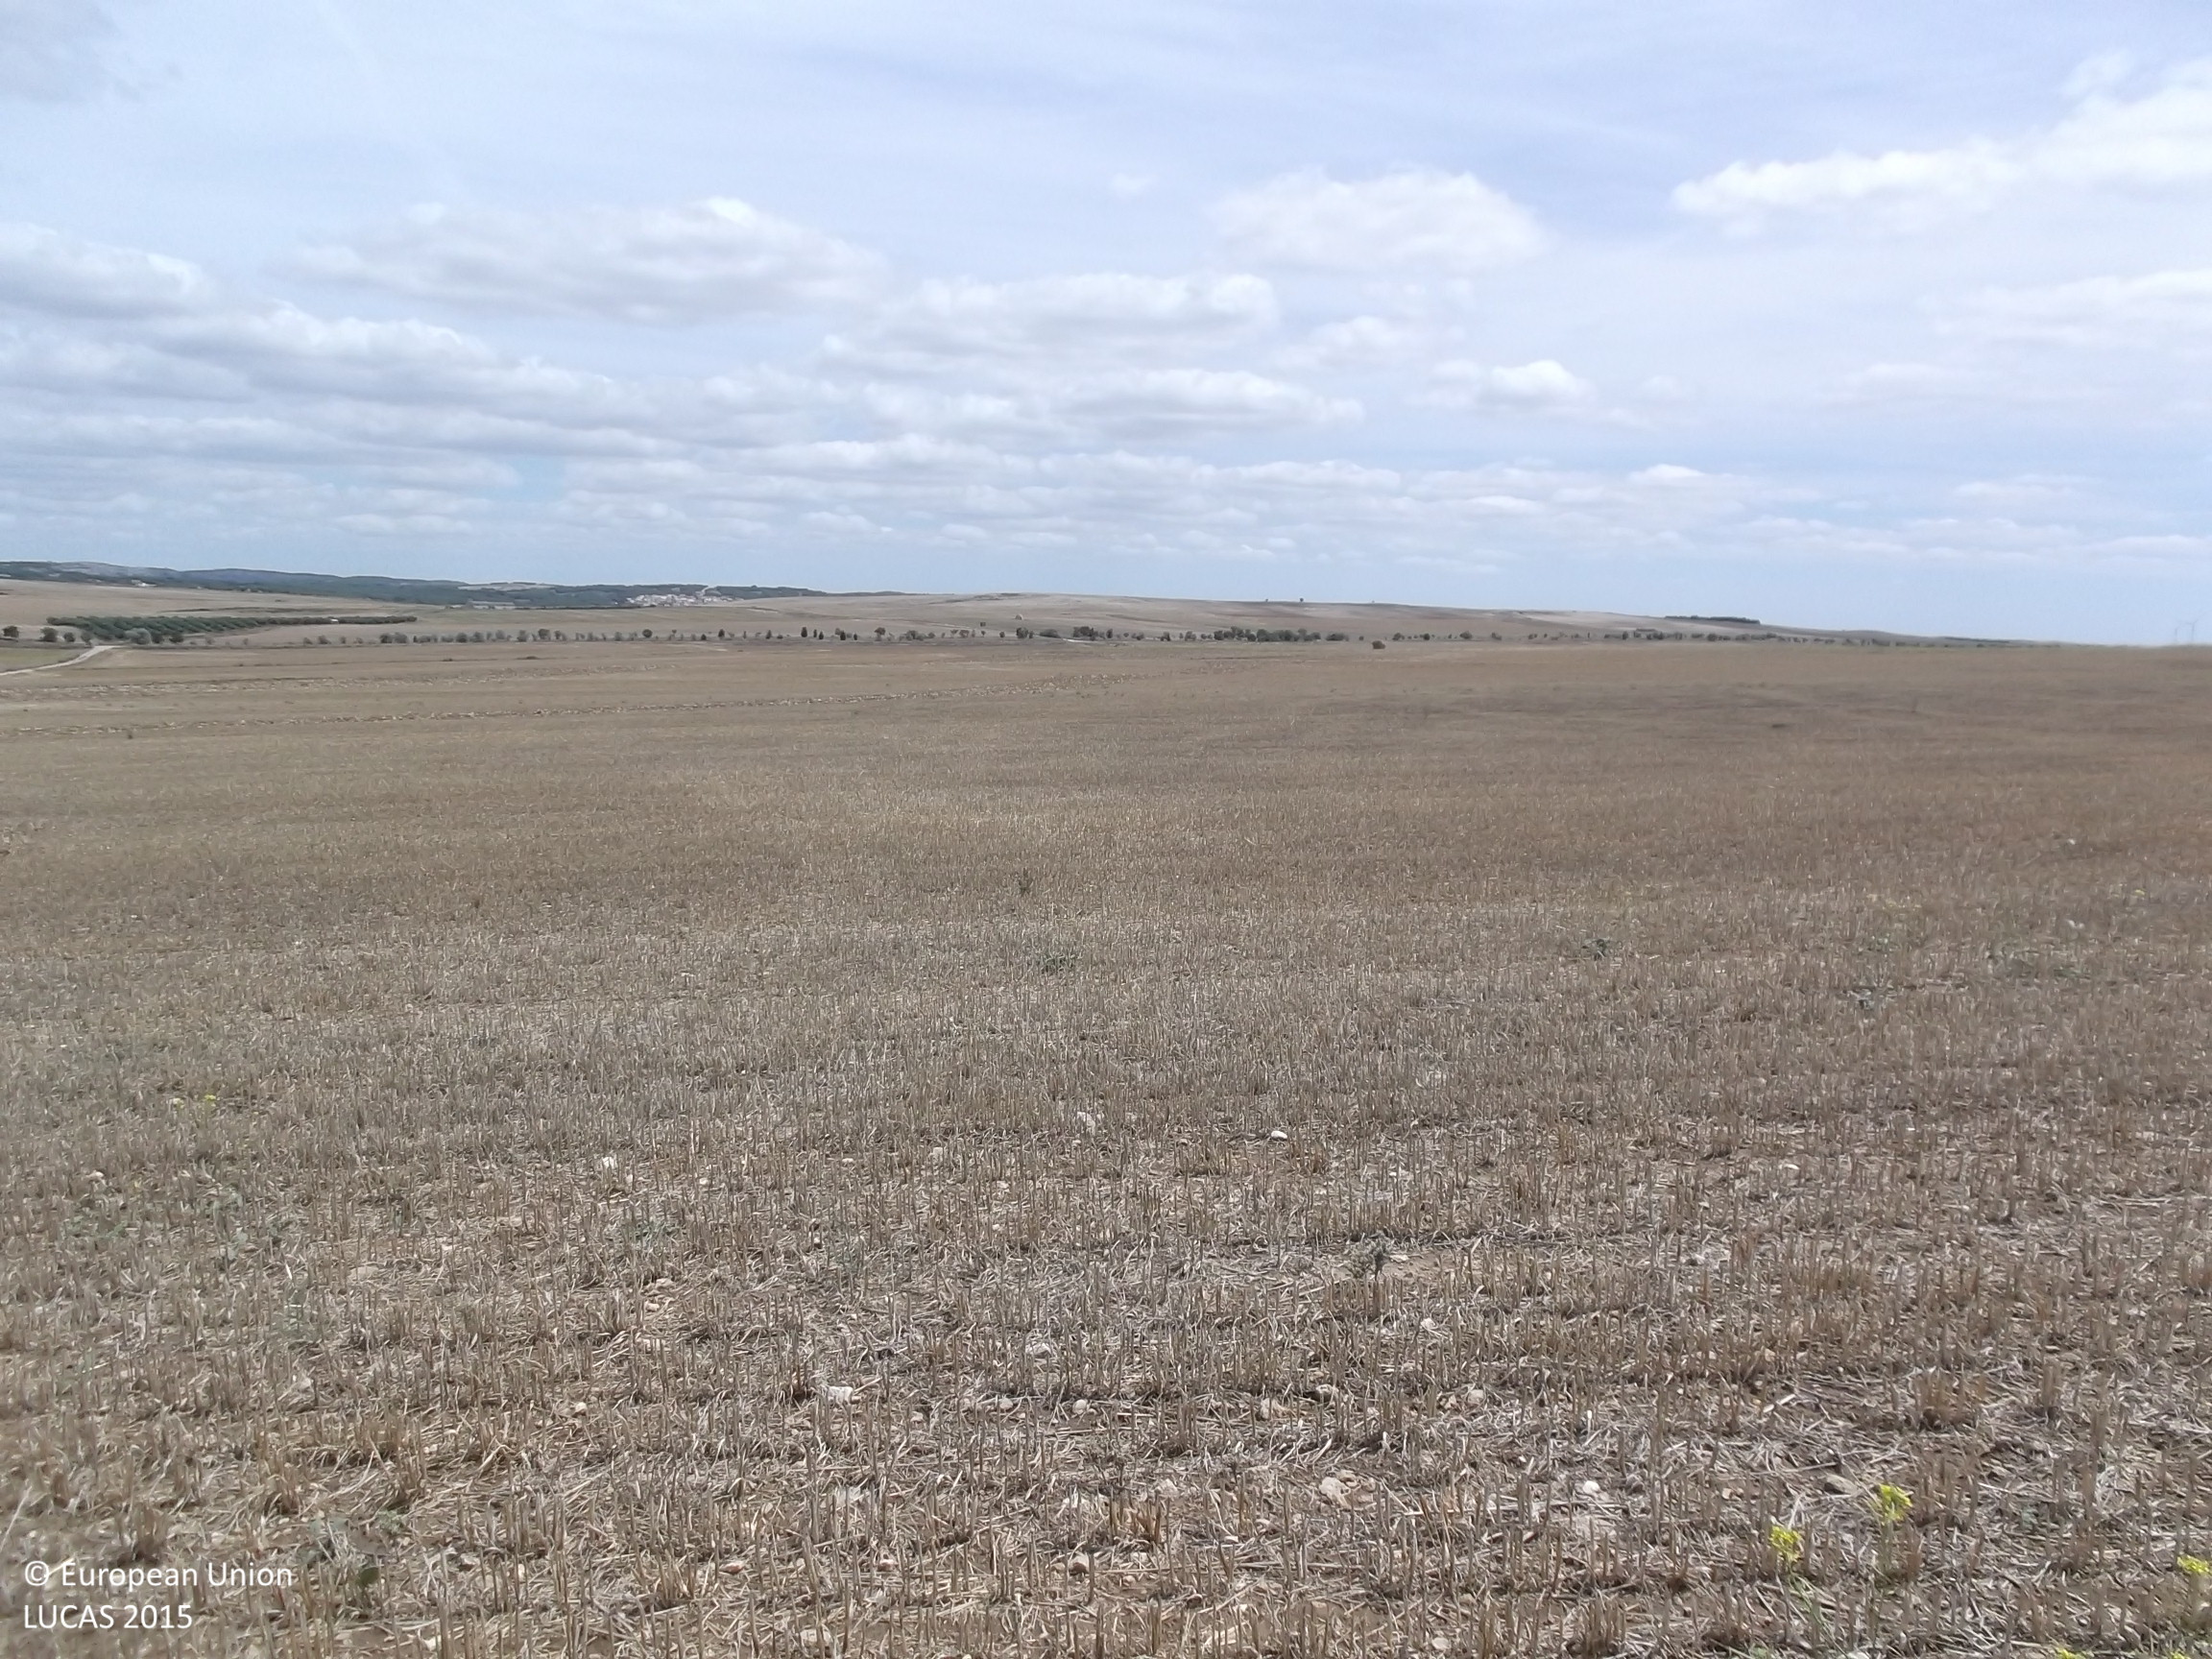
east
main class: Cropland
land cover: Oats
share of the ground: < 10 %
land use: Agriculture (excluding fallow land and kitchen gardens)
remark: Harvested field
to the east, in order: Oats; Other bare soil; Spontaneously vegetated surfaces
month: August
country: ES
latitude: 42.4678
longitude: -2.1428
